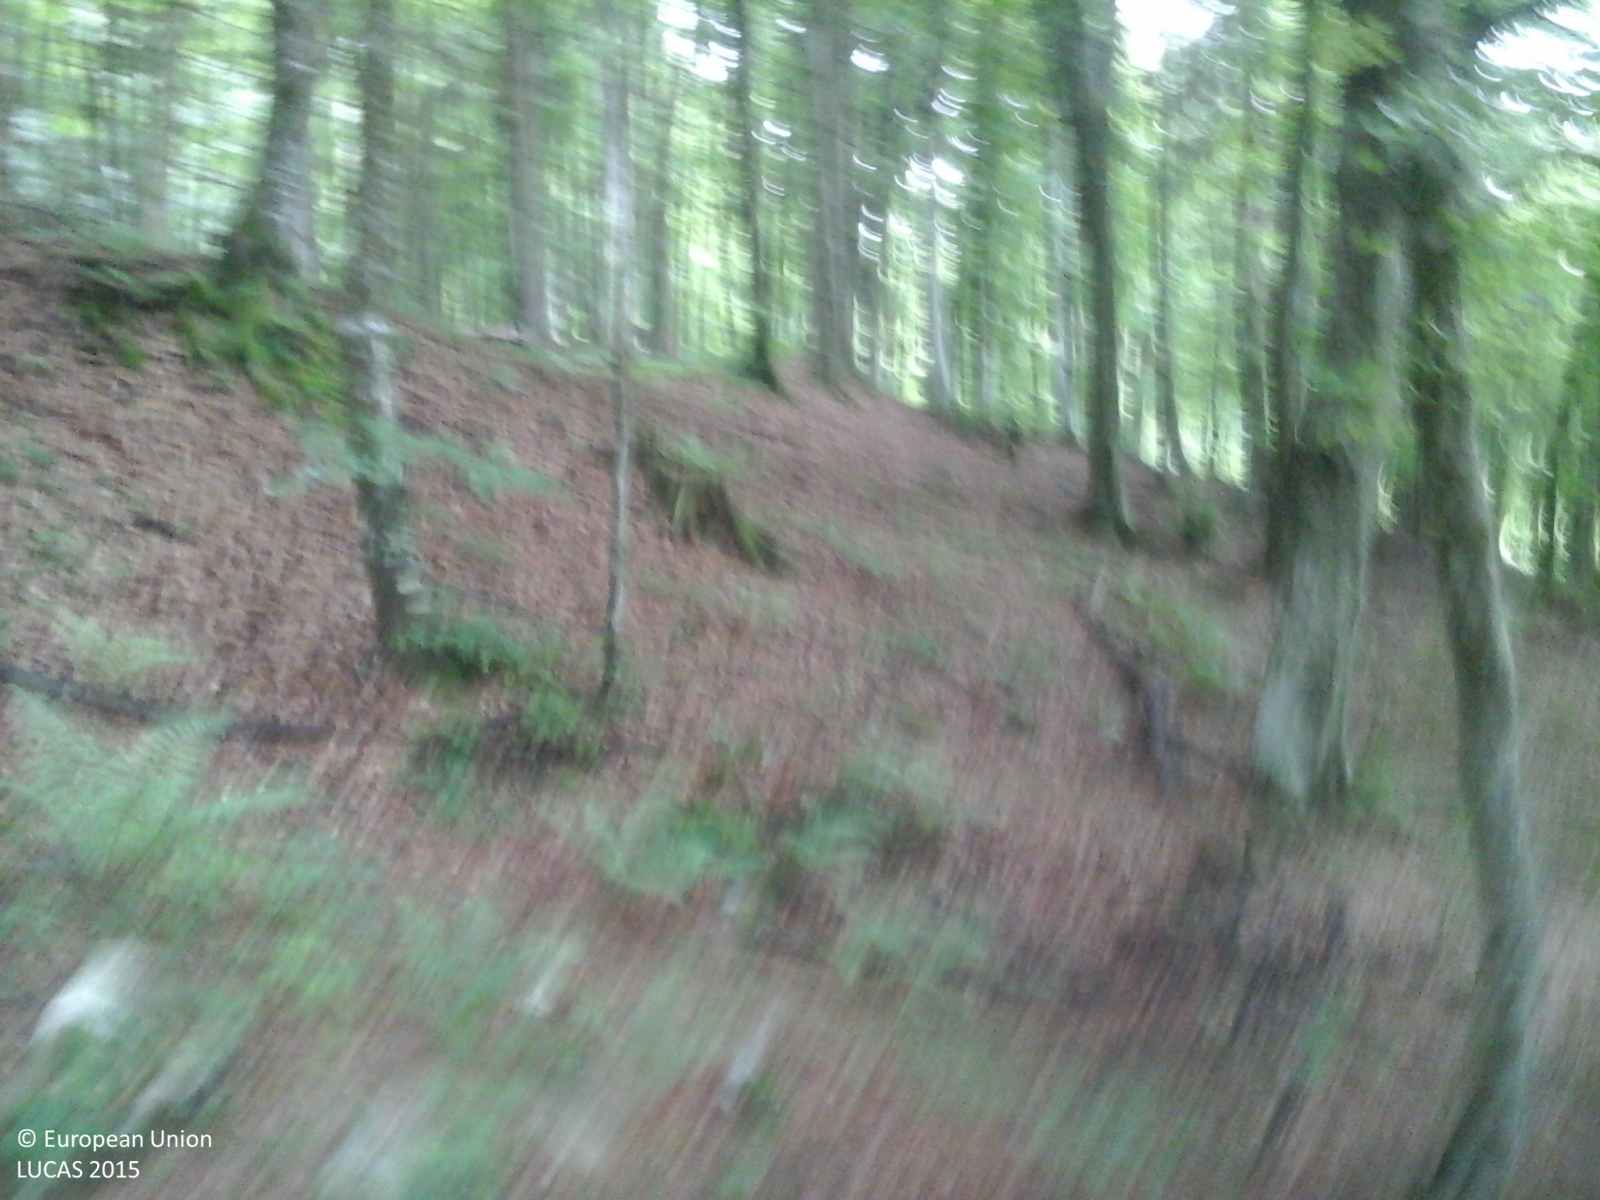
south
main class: Woodland
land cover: Broadleaved woodland
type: mountainous beech forest
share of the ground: > 75 %
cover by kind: broadleaved forest trees 95 %, coniferous forest trees 5 %
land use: Forestry
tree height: > 5 m
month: May
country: IT
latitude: 45.7886
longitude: 10.9376
